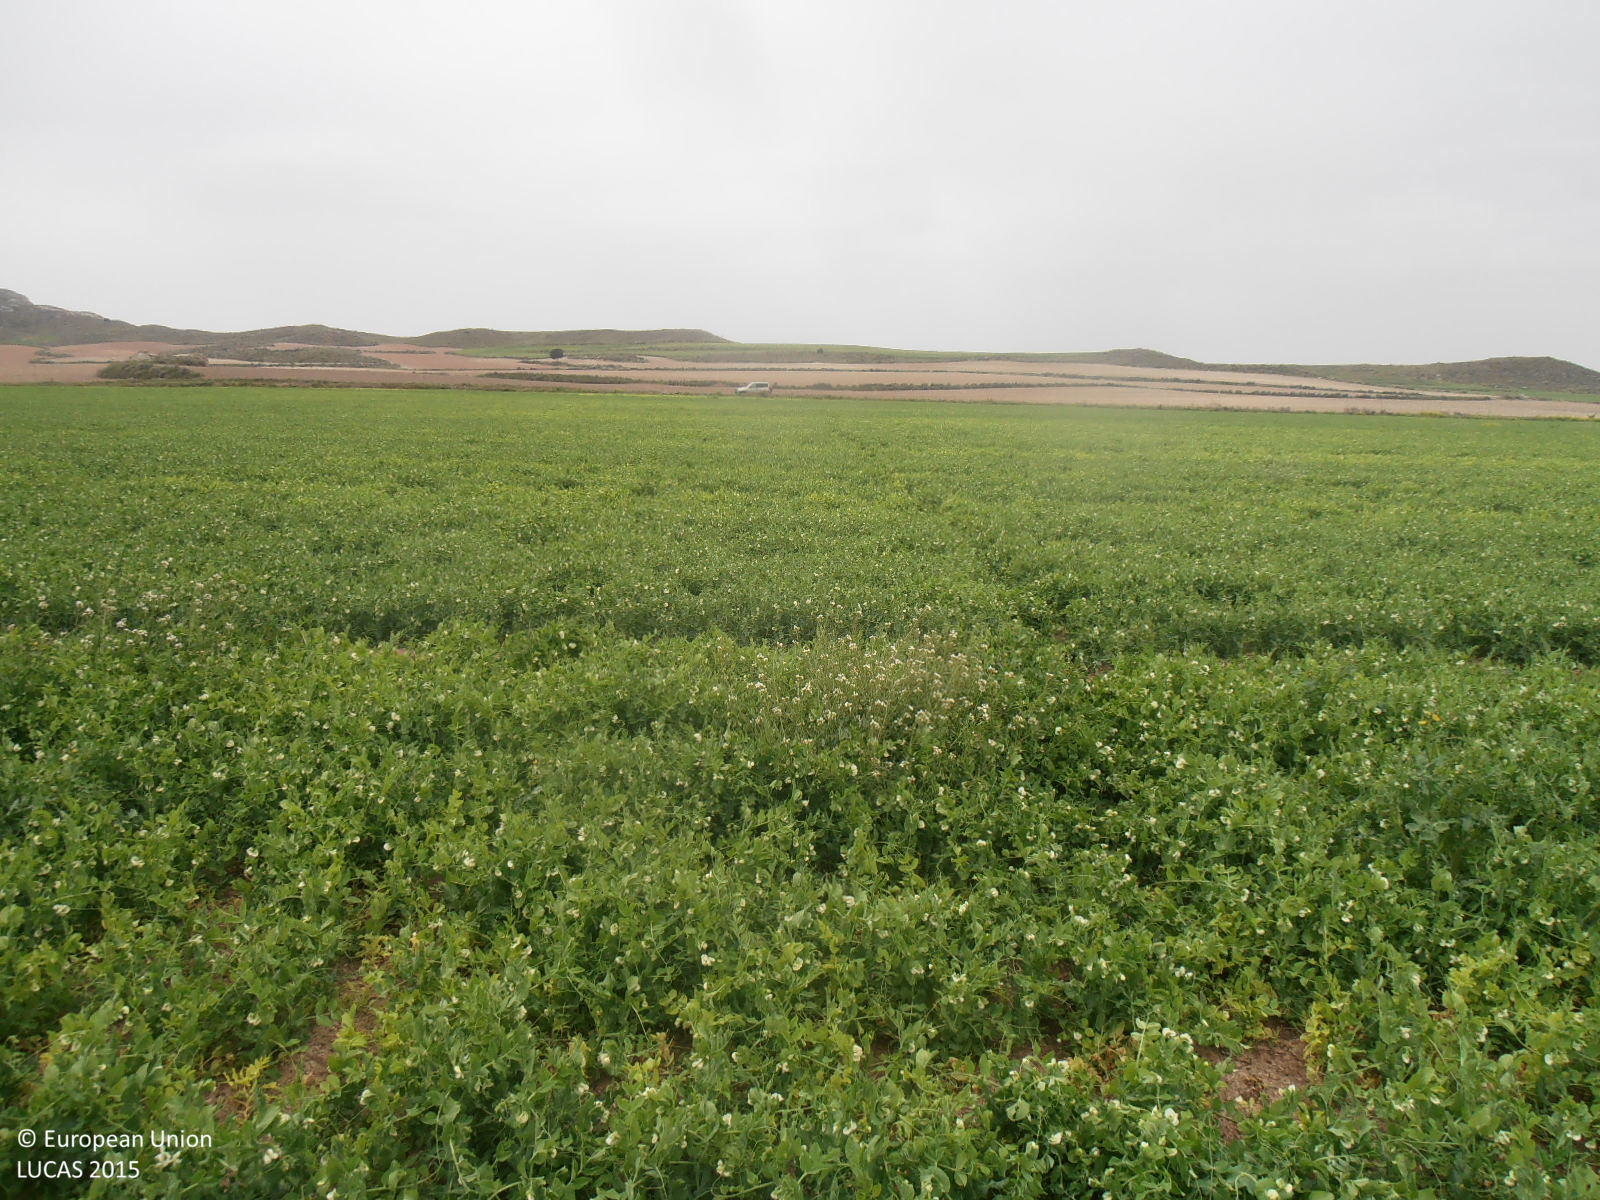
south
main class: Cropland
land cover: Dry pulses
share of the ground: > 75 %
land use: Agriculture (excluding fallow land and kitchen gardens)
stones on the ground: < 10 %
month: April
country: ES
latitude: 41.4445
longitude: -0.3938
